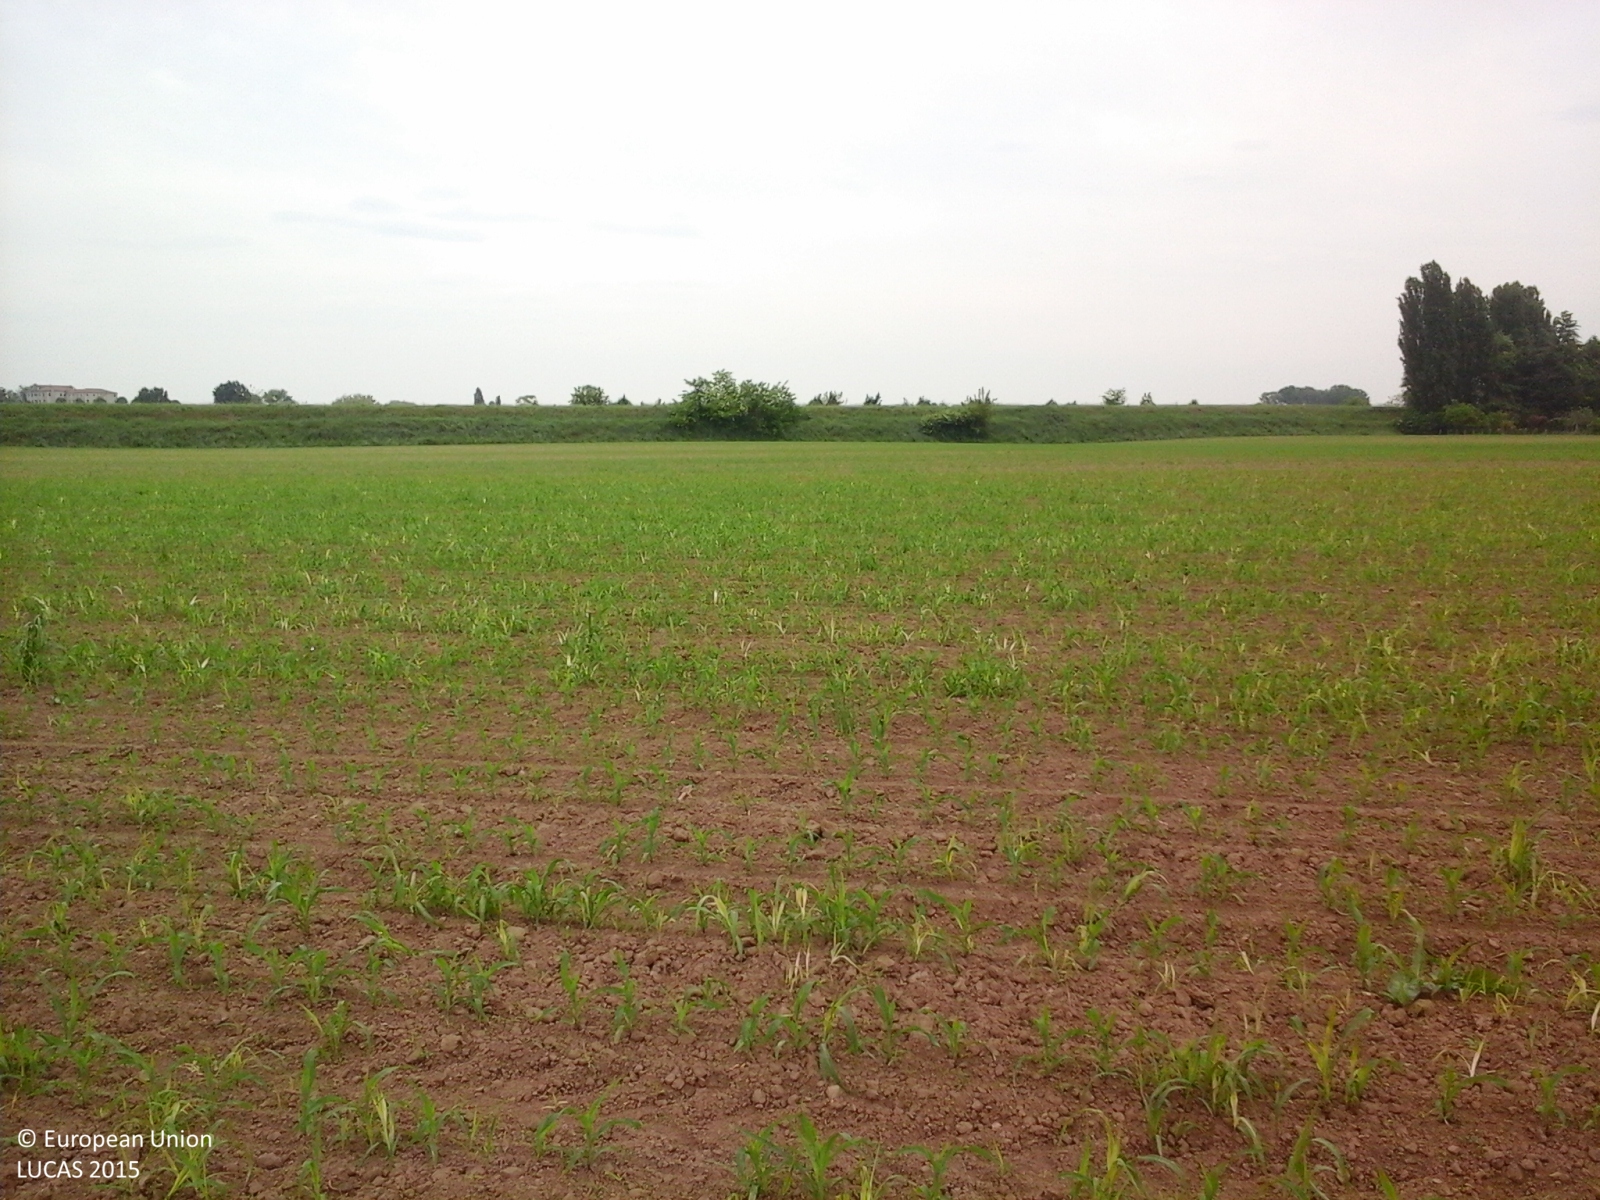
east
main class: Cropland
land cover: Maize
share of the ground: 10 - 25 %
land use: Agriculture (excluding fallow land and kitchen gardens)
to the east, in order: Maize; Grassland with sparse tree/shrub cover; Inland fresh running water; Grassland with sparse tree/shrub cover; Paved roads, cycling and walking lanes; Grassland with sparse tree/shrub cover
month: May
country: IT
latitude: 45.2205
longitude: 11.6907
